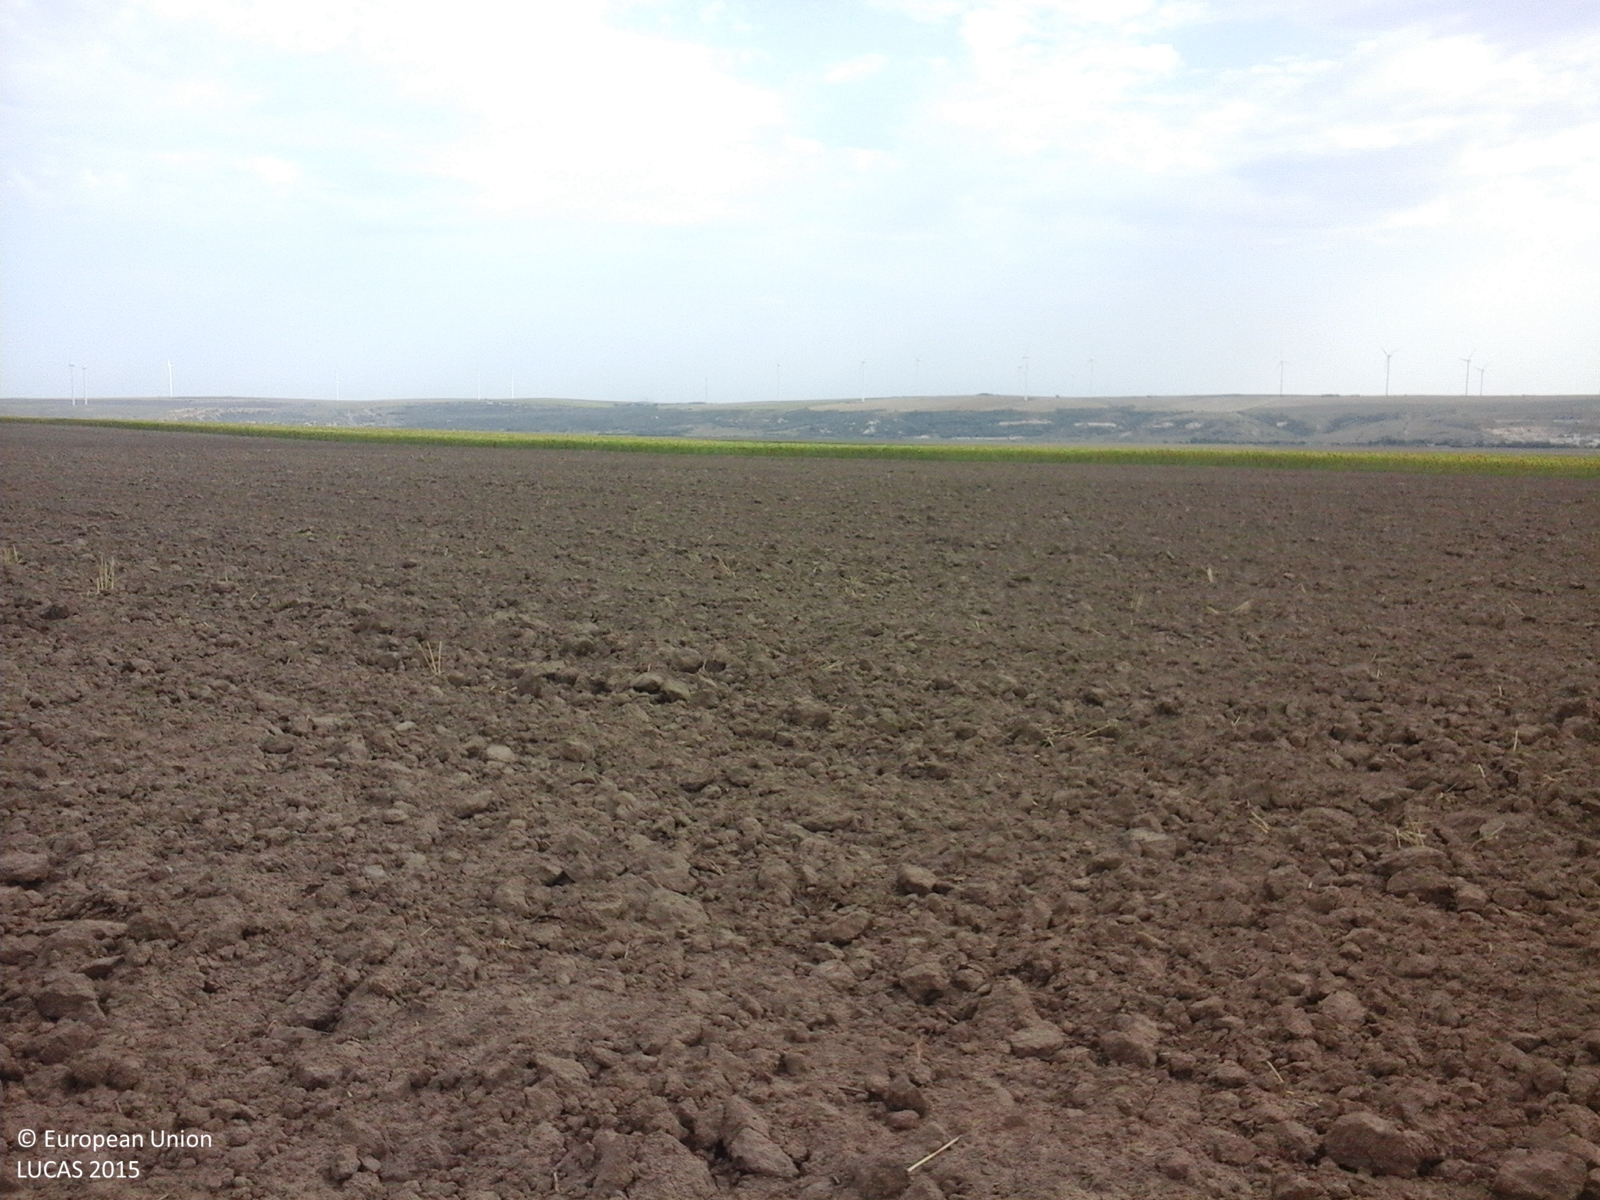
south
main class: Cropland
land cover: Common wheat
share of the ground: < 10 %
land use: Agriculture (excluding fallow land and kitchen gardens)
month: August
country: RO
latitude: 44.3545
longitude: 28.1645
